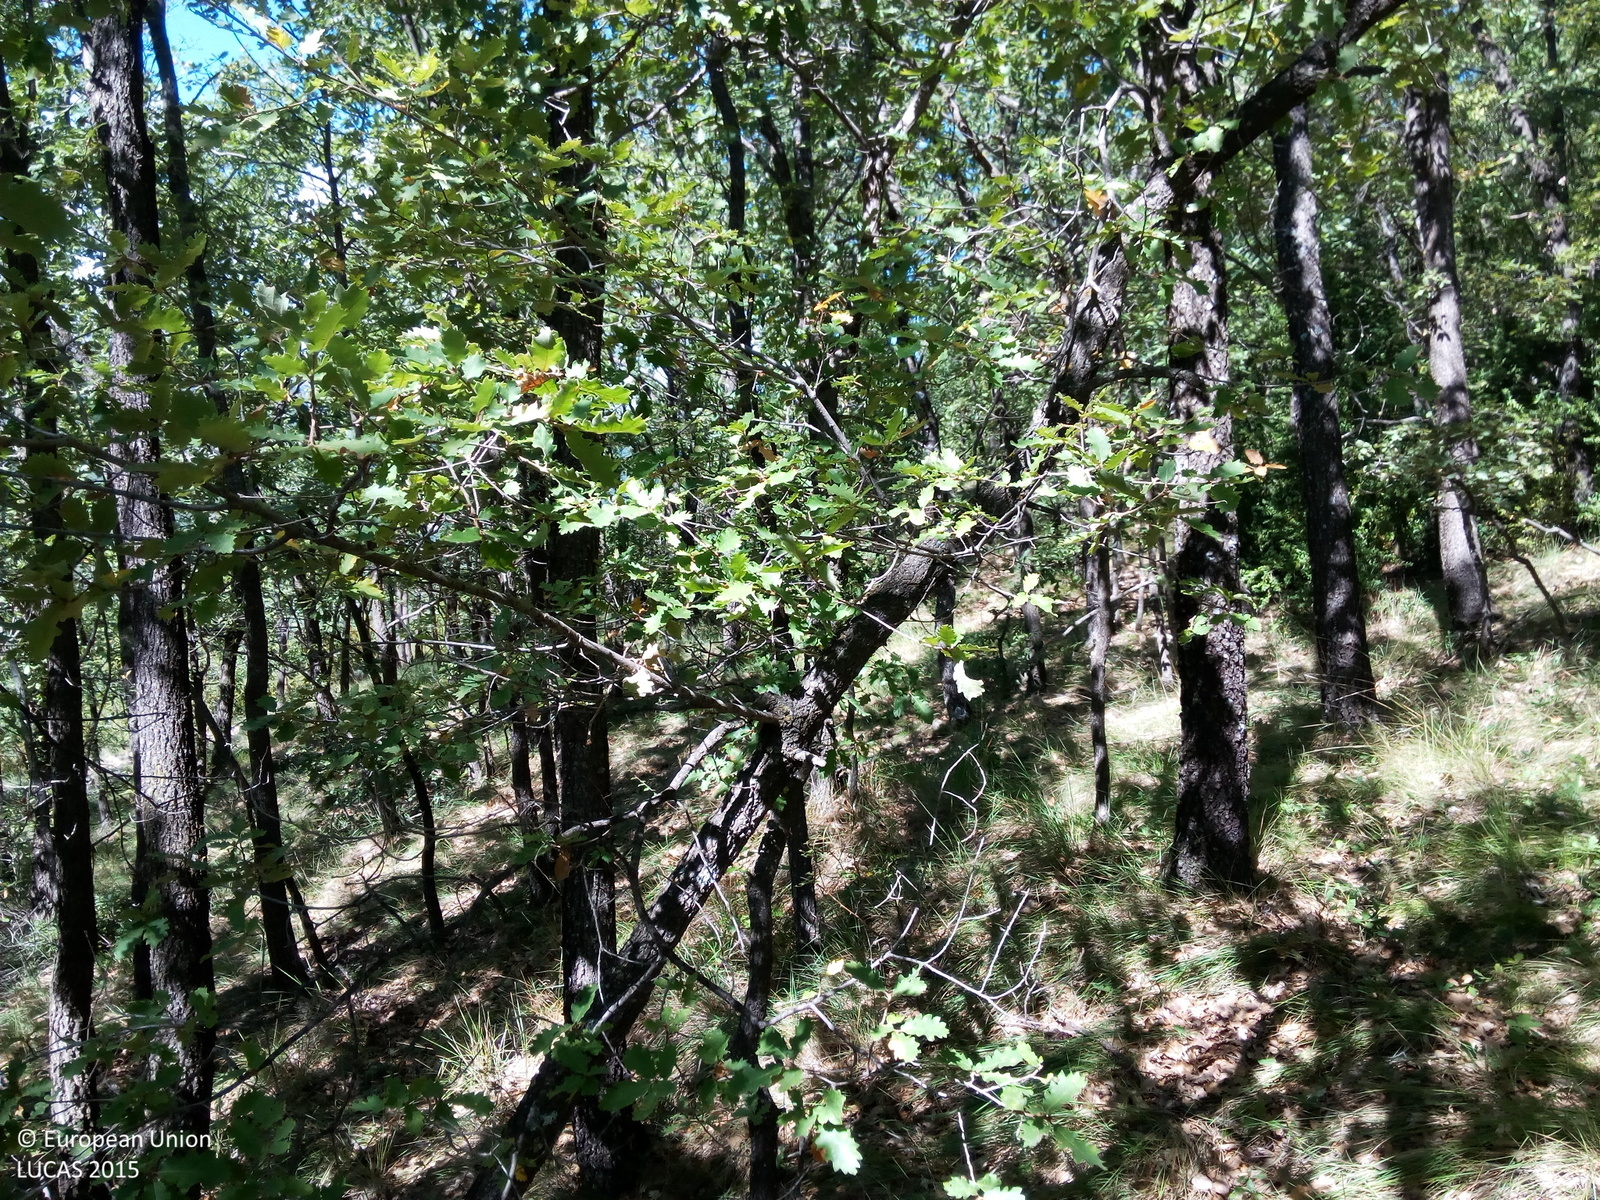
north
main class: Woodland
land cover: Broadleaved woodland
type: broadleaved evergreen forest
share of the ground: > 75 %
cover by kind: broadleaved forest trees 100 %
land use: Semi-natural and natural areas not in use
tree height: > 5 m
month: September
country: ES
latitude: 42.3409
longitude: 0.5751
